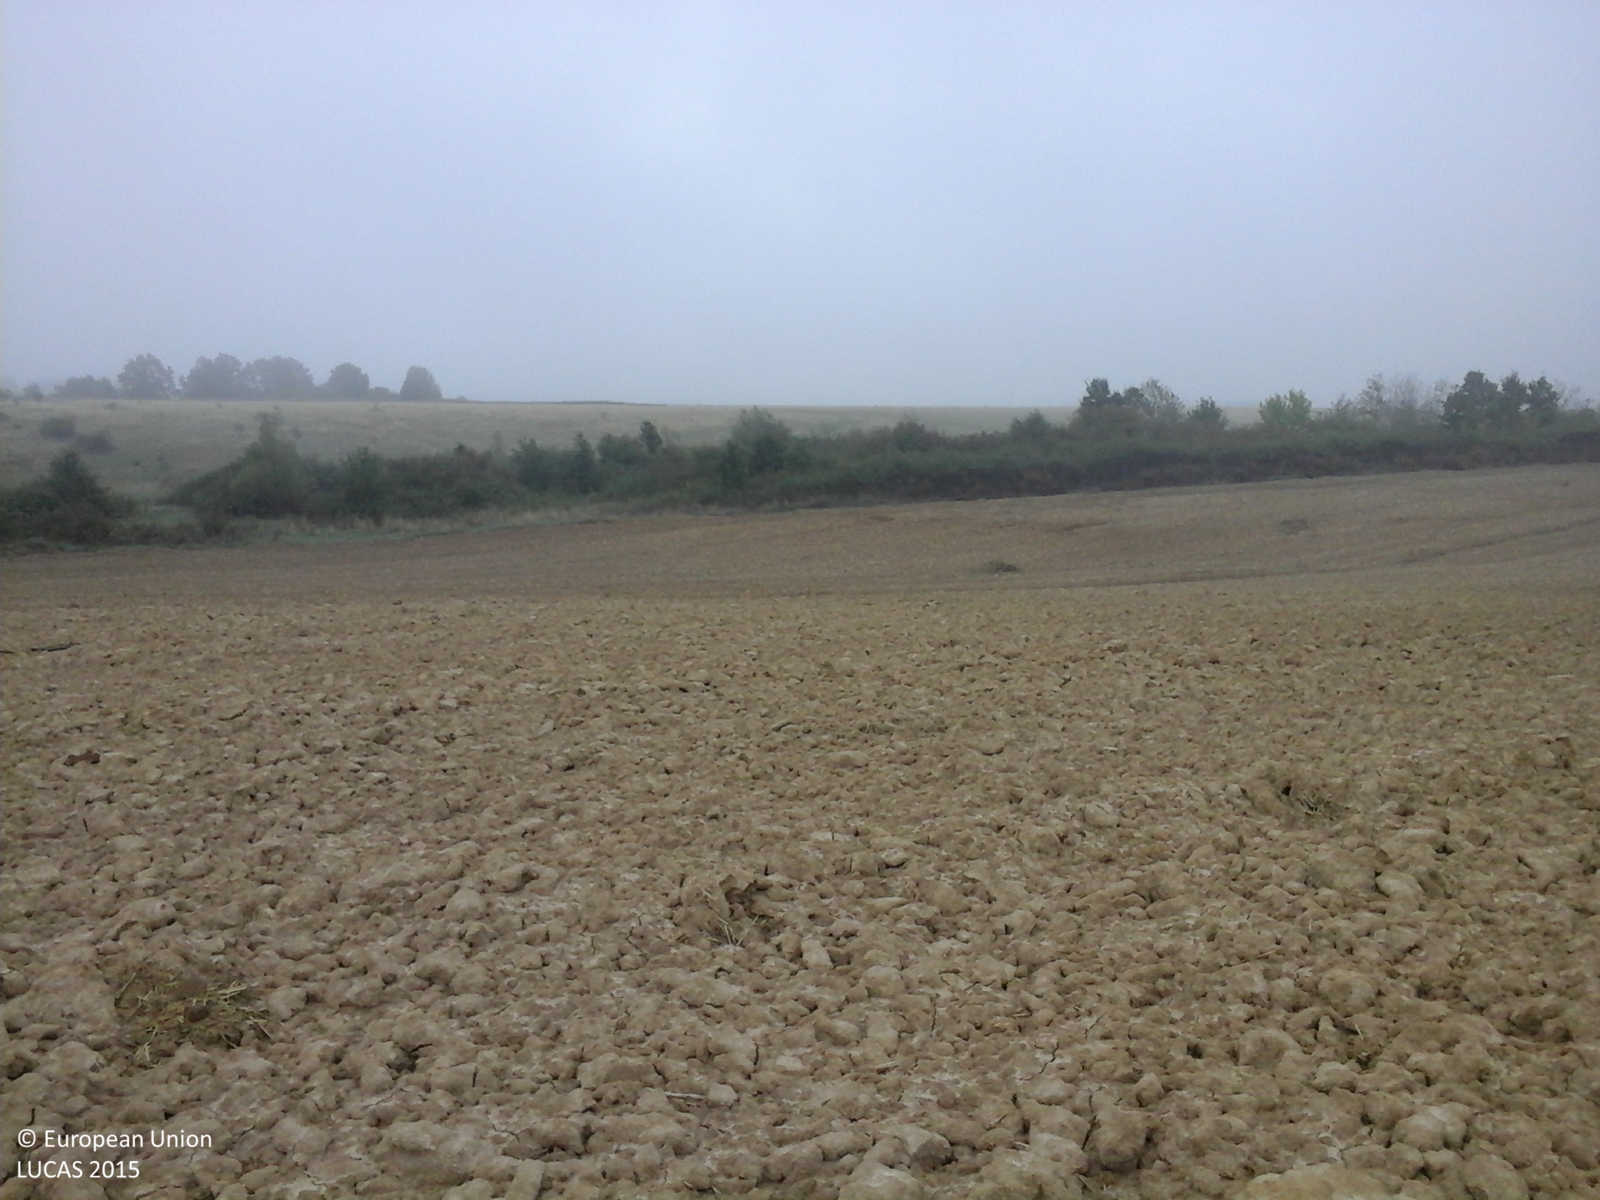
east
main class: Cropland
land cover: Common wheat
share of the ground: < 10 %
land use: Agriculture (excluding fallow land and kitchen gardens)
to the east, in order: Common wheat; Shrubland without tree cover; Ditches and canals; Abandoned hedges; Grassland without tree/shrub cover; Tracks; Grassland without tree/shrub cover
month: September
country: RO
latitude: 45.5616
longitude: 22.0180
